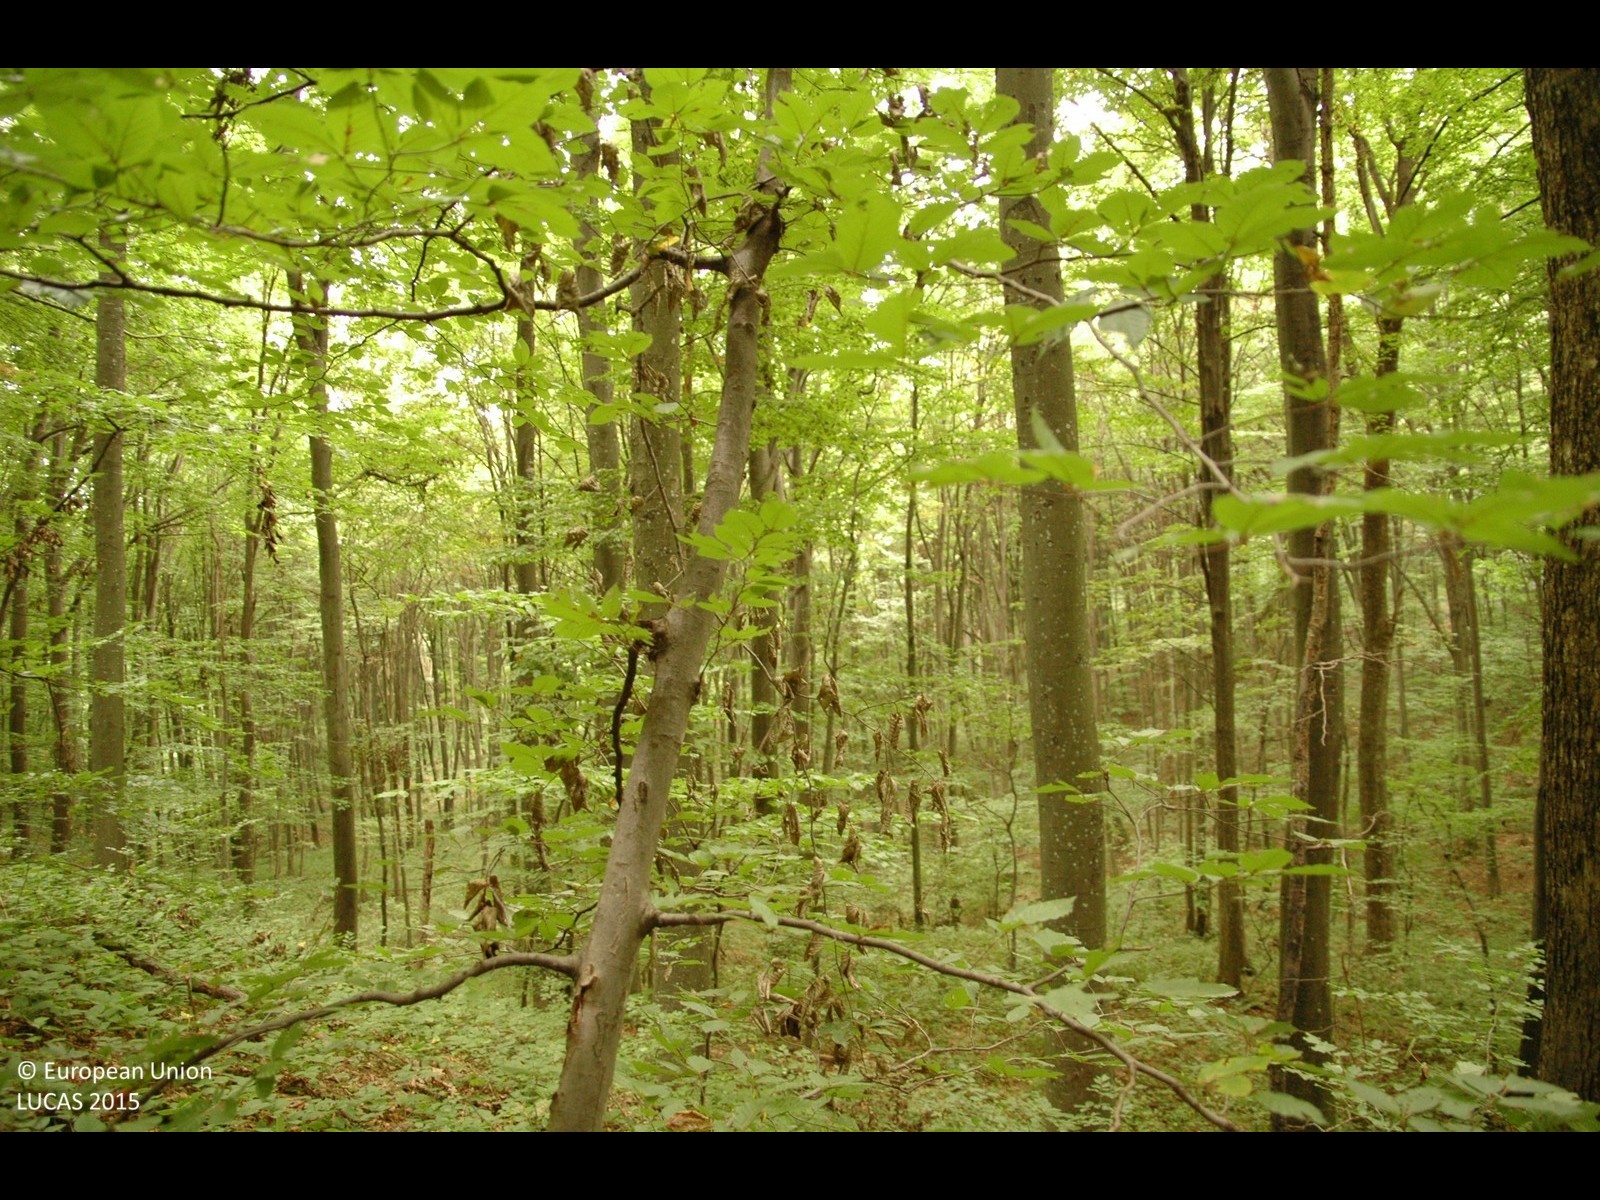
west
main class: Woodland
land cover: Broadleaved woodland
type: beech forest
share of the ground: > 75 %
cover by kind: broadleaved forest trees 100 %
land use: Forestry
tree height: > 5 m
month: September
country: HR
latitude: 46.0877
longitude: 16.6868
